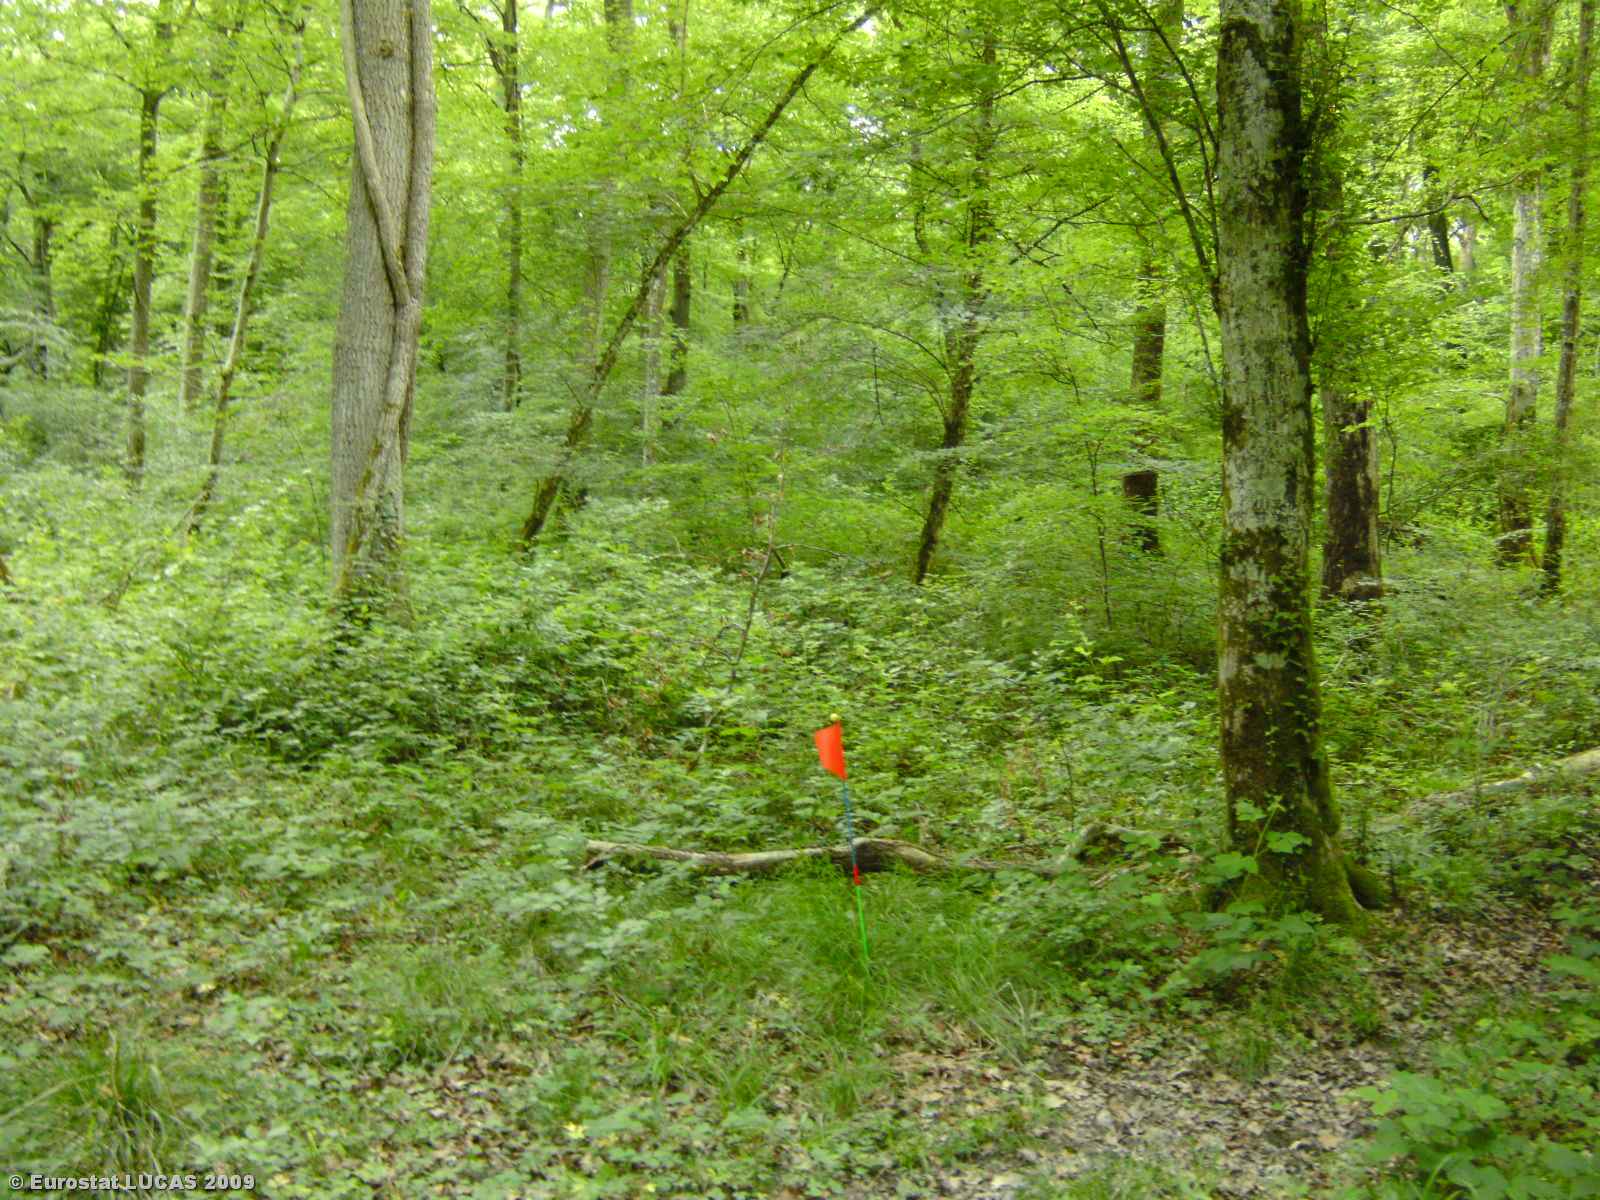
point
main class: Woodland
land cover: Broadleaved woodland
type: mesophytic deciduous forest
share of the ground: > 75 %
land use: Forestry
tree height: > 5 m
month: May
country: LU
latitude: 49.8510
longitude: 6.2025
